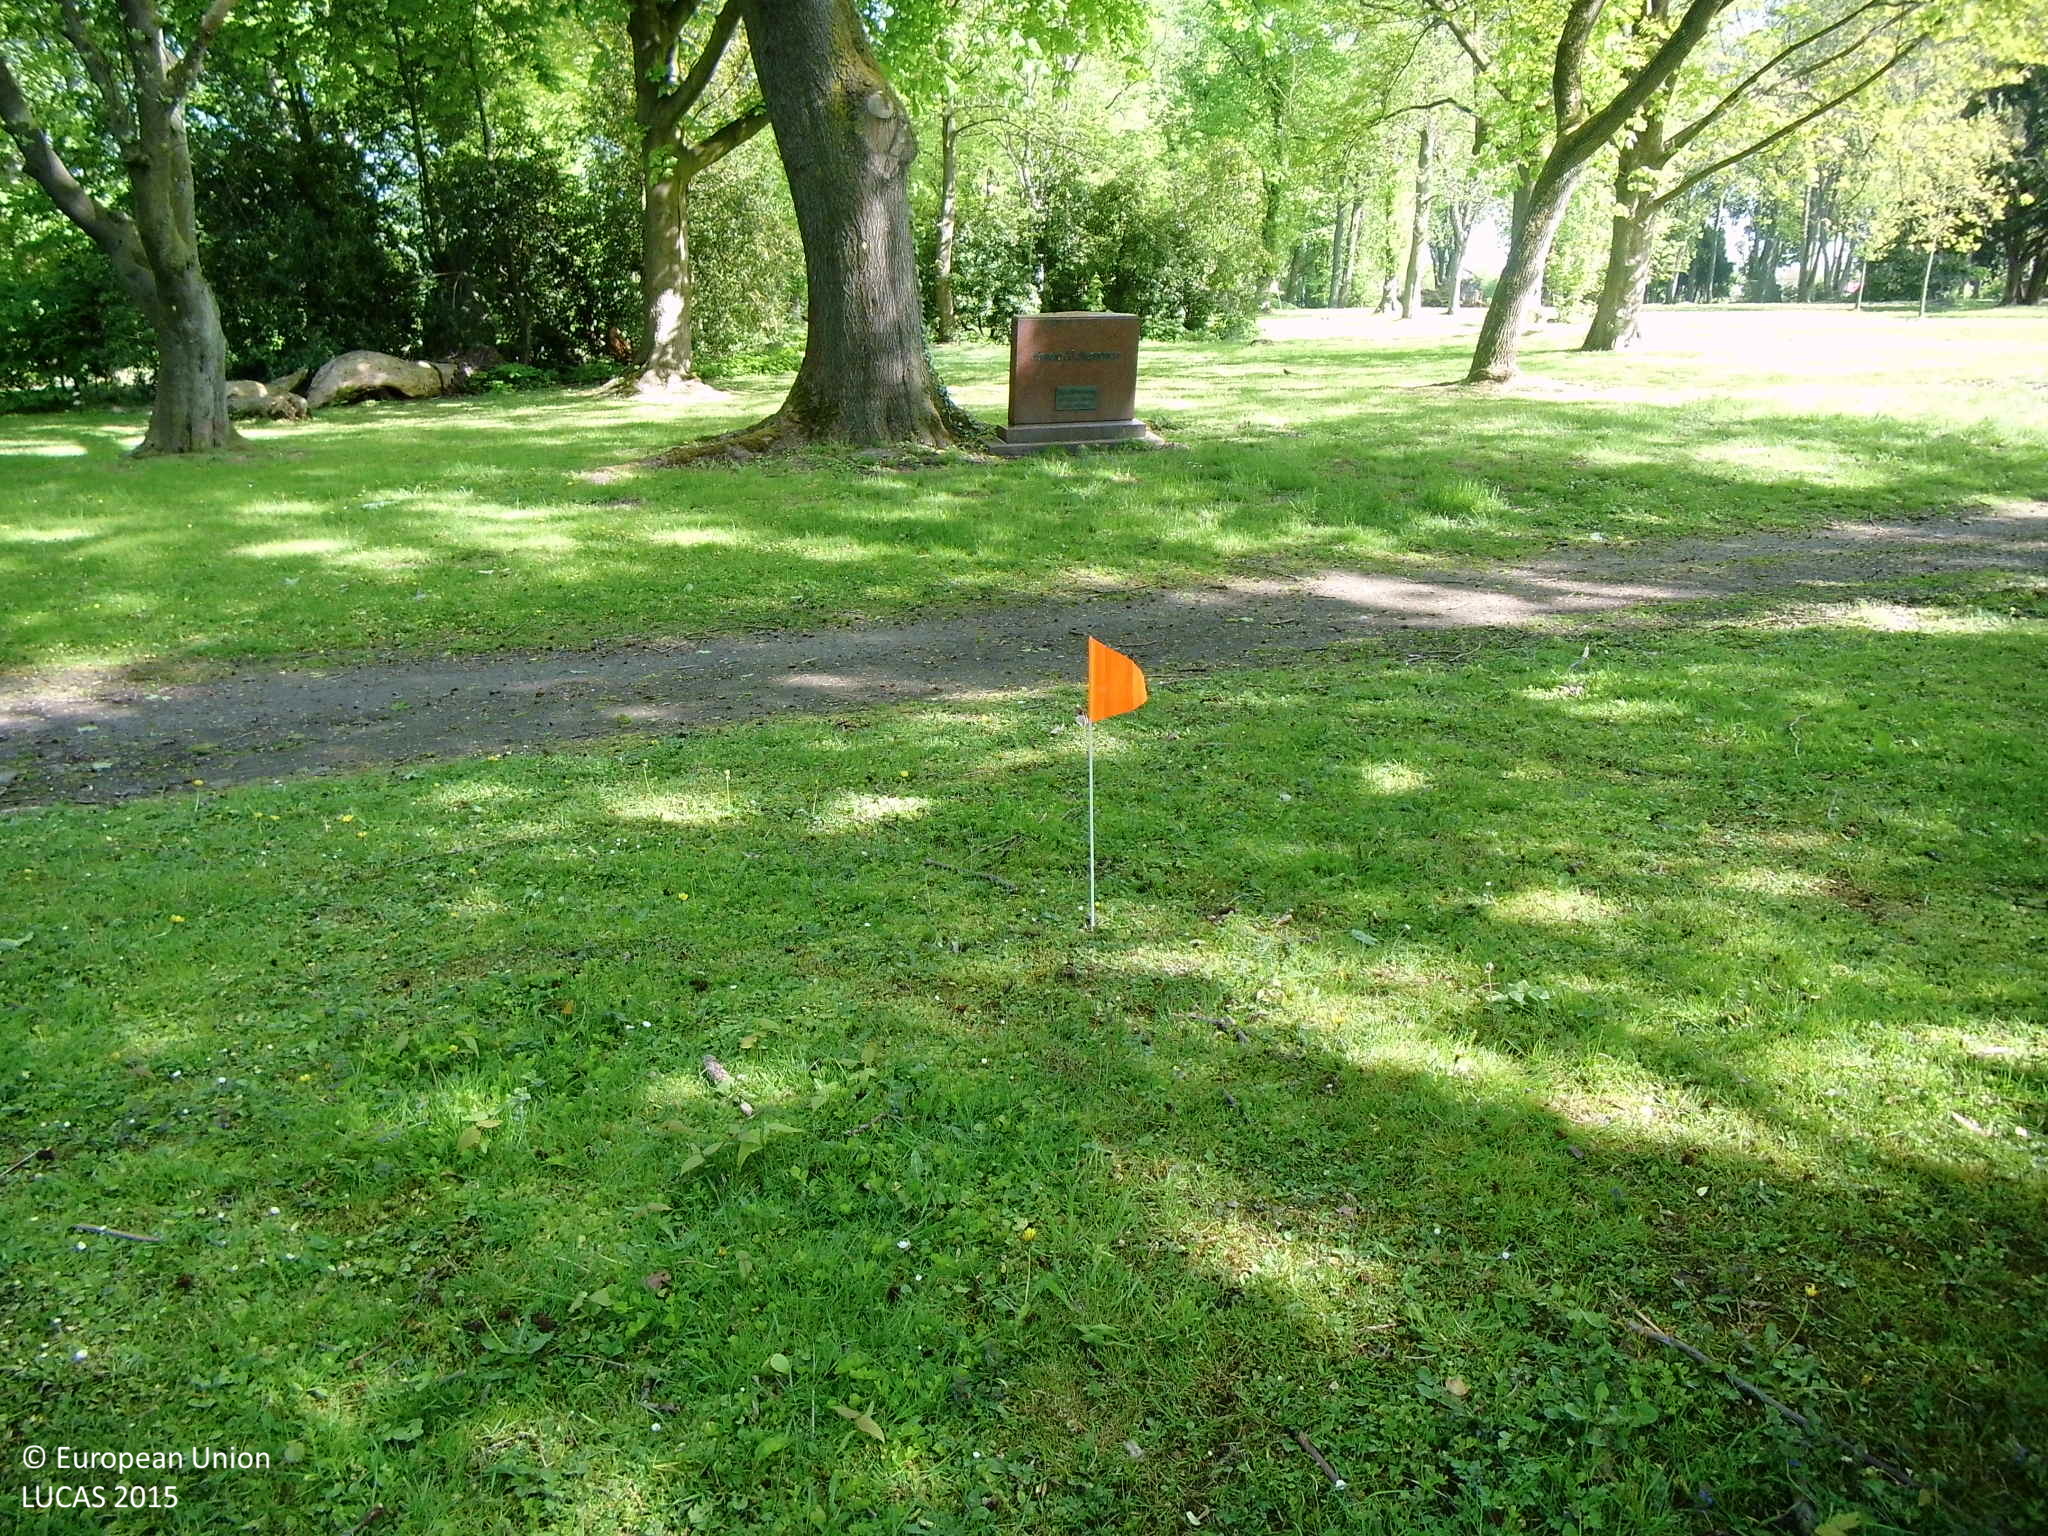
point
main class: Woodland
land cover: Broadleaved woodland
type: mesophytic deciduous forest
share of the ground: > 75 %
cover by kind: broadleaved forest trees 80 %, herbaceous plants 10 %, shrubs 5 %, unconsolidated bare surface 5 %
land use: Community services
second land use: Amenities, museums, leisure
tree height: > 5 m
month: May
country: DE
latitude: 51.5042
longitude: 7.4214
